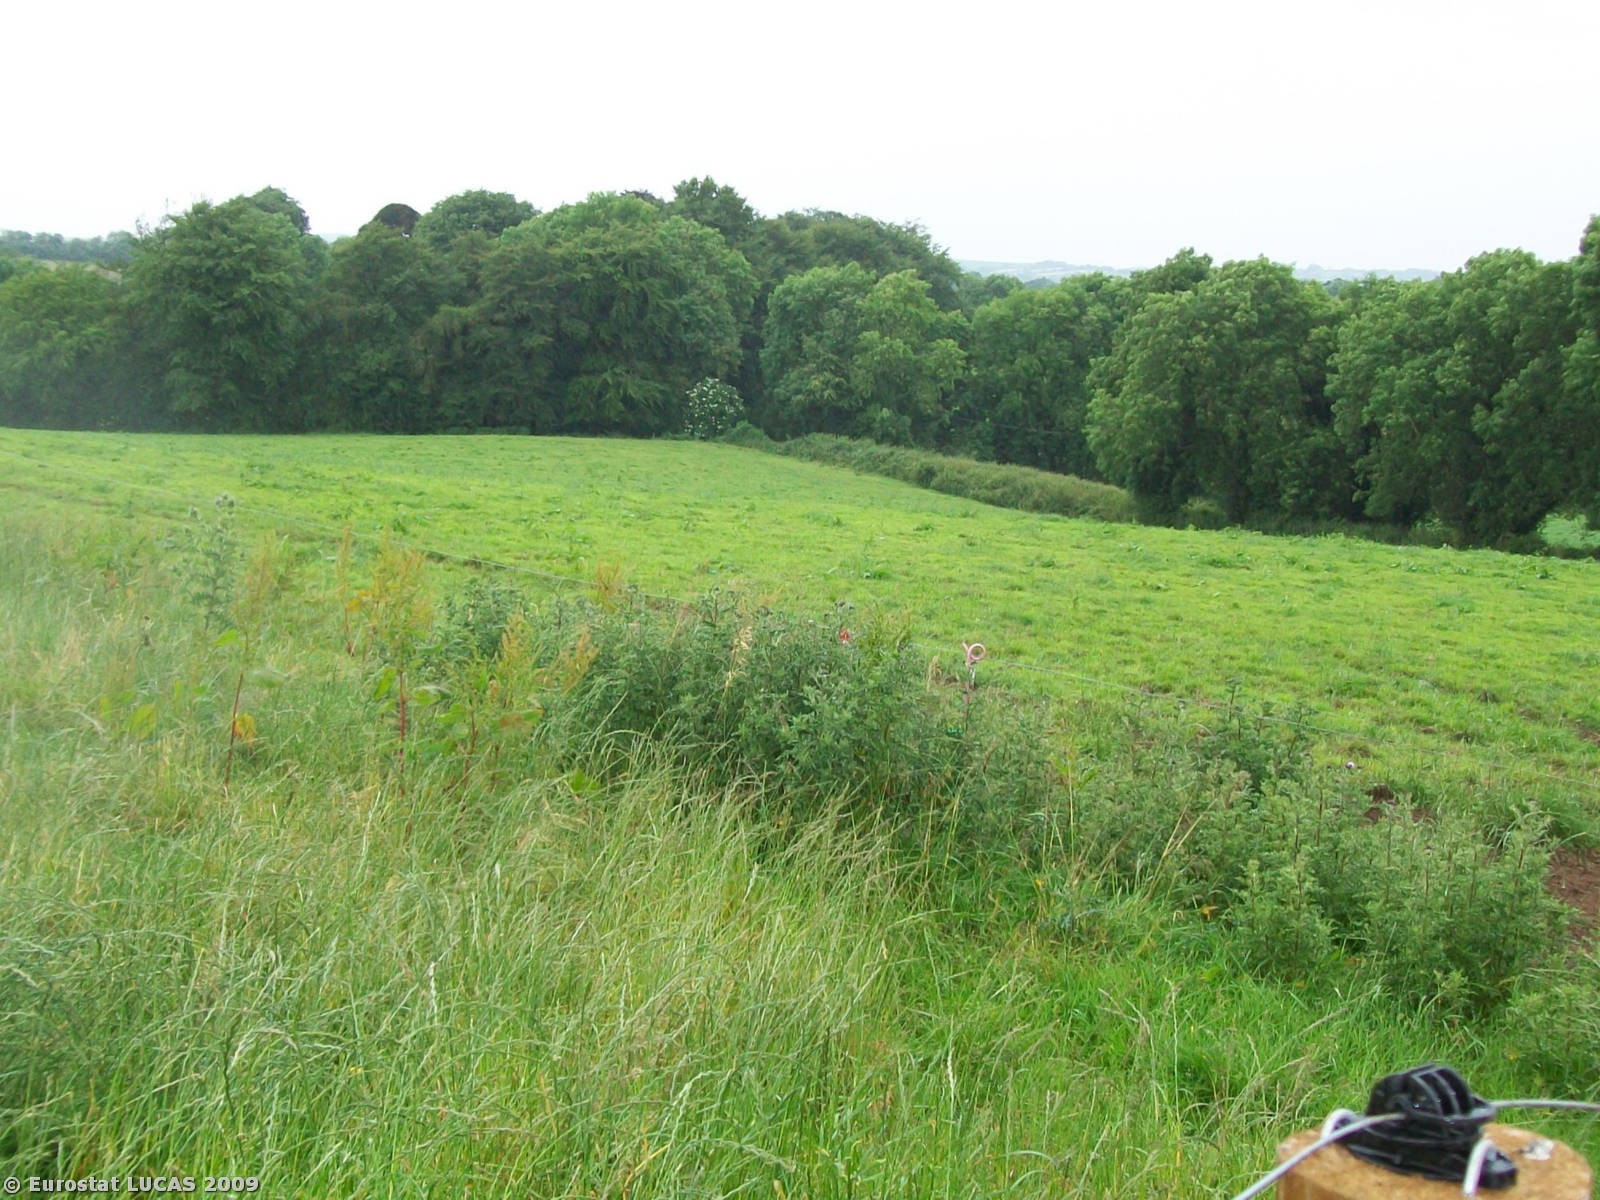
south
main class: Grassland
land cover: Grassland without tree/shrub cover
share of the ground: > 75 %
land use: Agriculture (excluding fallow land and kitchen gardens)
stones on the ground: < 10 %
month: June
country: GB
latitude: 54.4916
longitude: -7.3649
